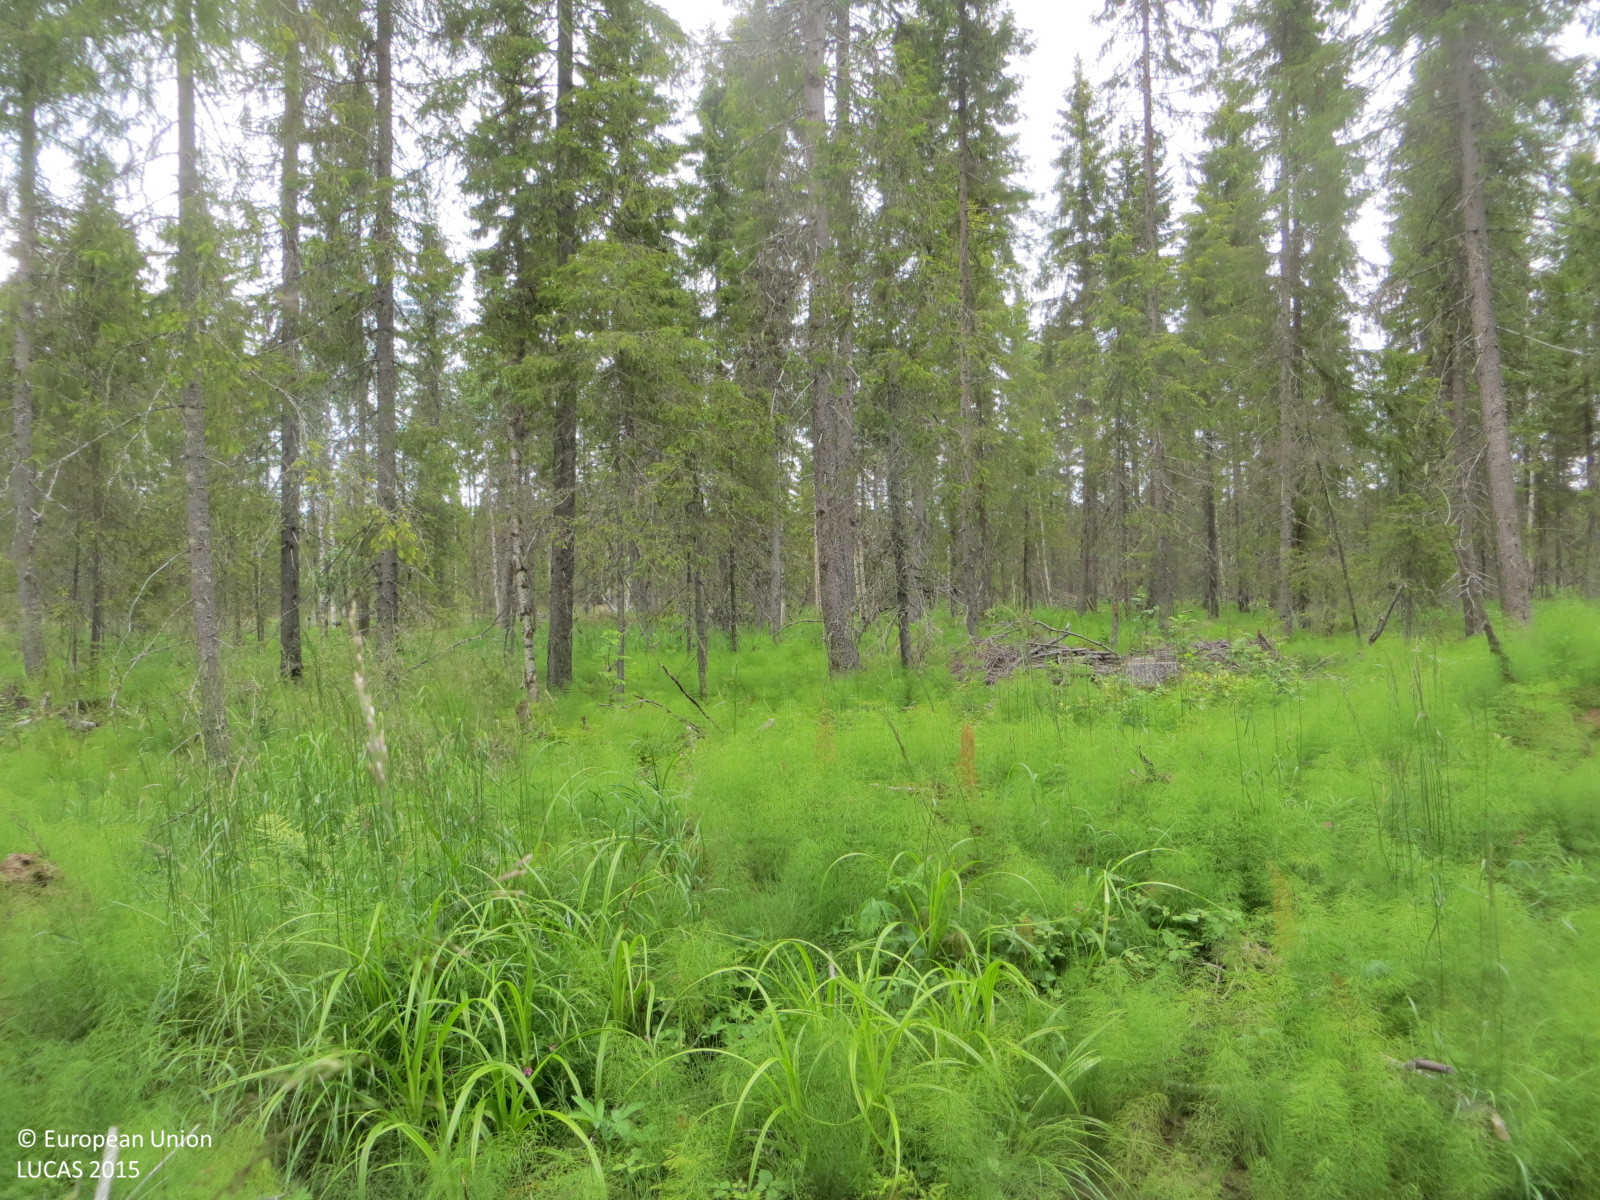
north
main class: Woodland
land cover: Spruce dominated coniferous woodland
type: boreal forest
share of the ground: 50 - 75 %
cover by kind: coniferous forest trees 60 %, shrubs 35 %, broadleaved forest trees 5 %
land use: Forestry
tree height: > 5 m
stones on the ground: < 10 %
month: July
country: FI
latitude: 66.1555
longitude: 23.9393
